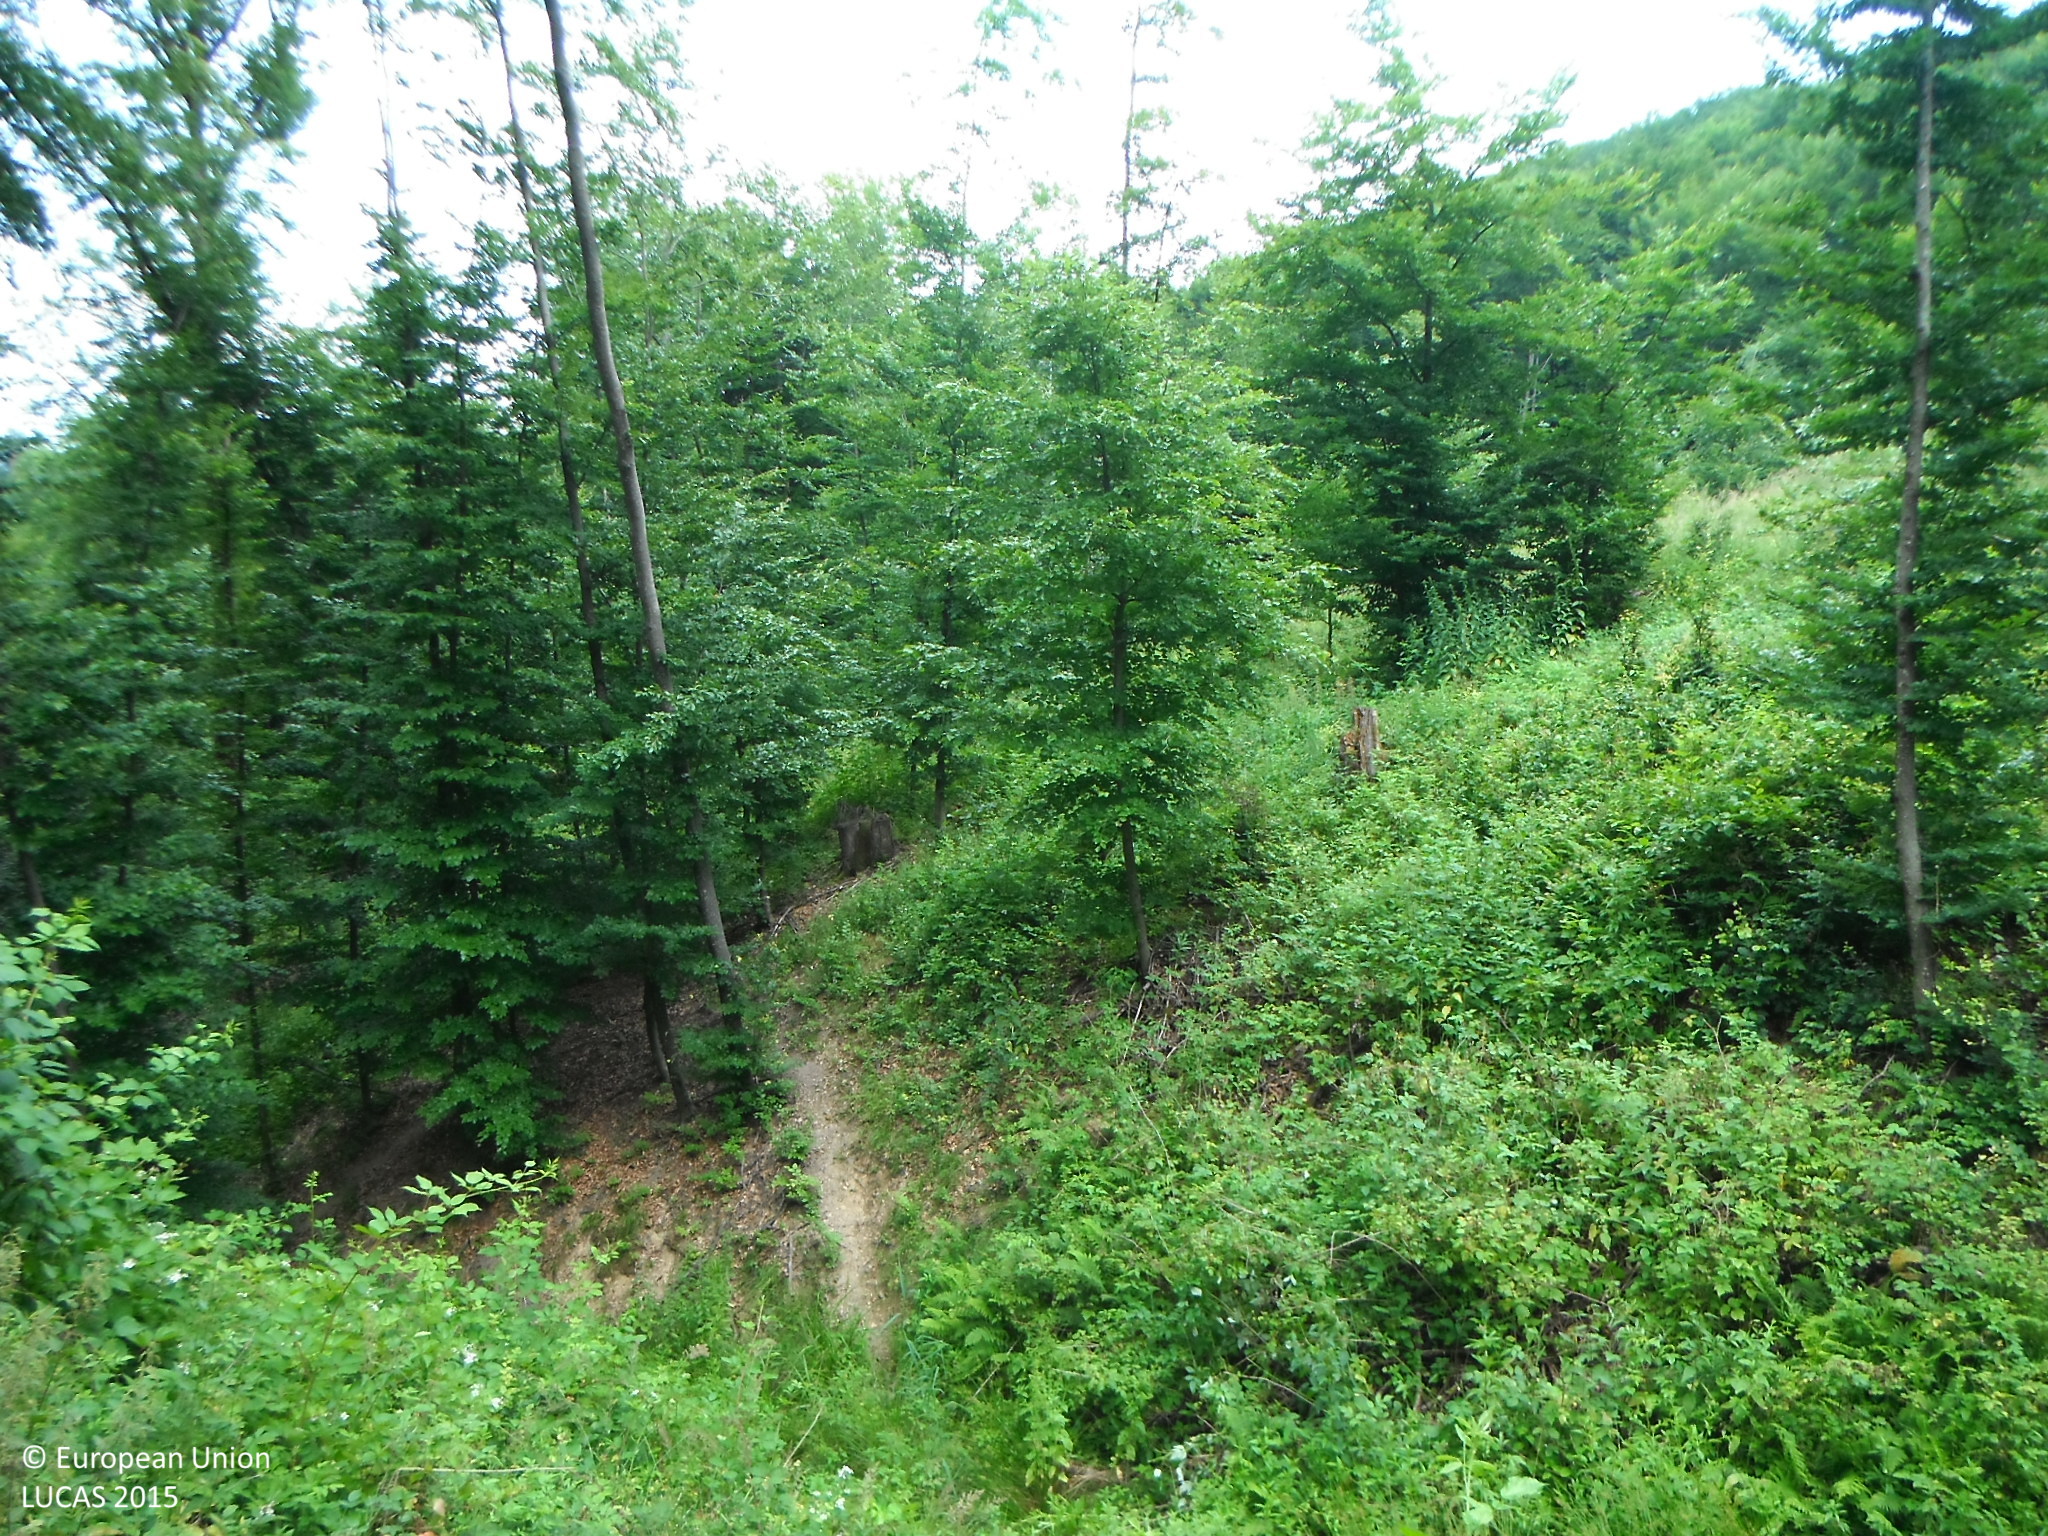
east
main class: Woodland
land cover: Broadleaved woodland
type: beech forest
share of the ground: > 75 %
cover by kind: broadleaved forest trees 90 %, shrubs 10 %
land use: Forestry
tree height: < 5 m
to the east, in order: Broadleaved woodland; Shrubland without tree cover; Ditches and canals; Shrubland without tree cover; Broadleaved woodland
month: July
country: SK
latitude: 48.5872
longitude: 20.1585
